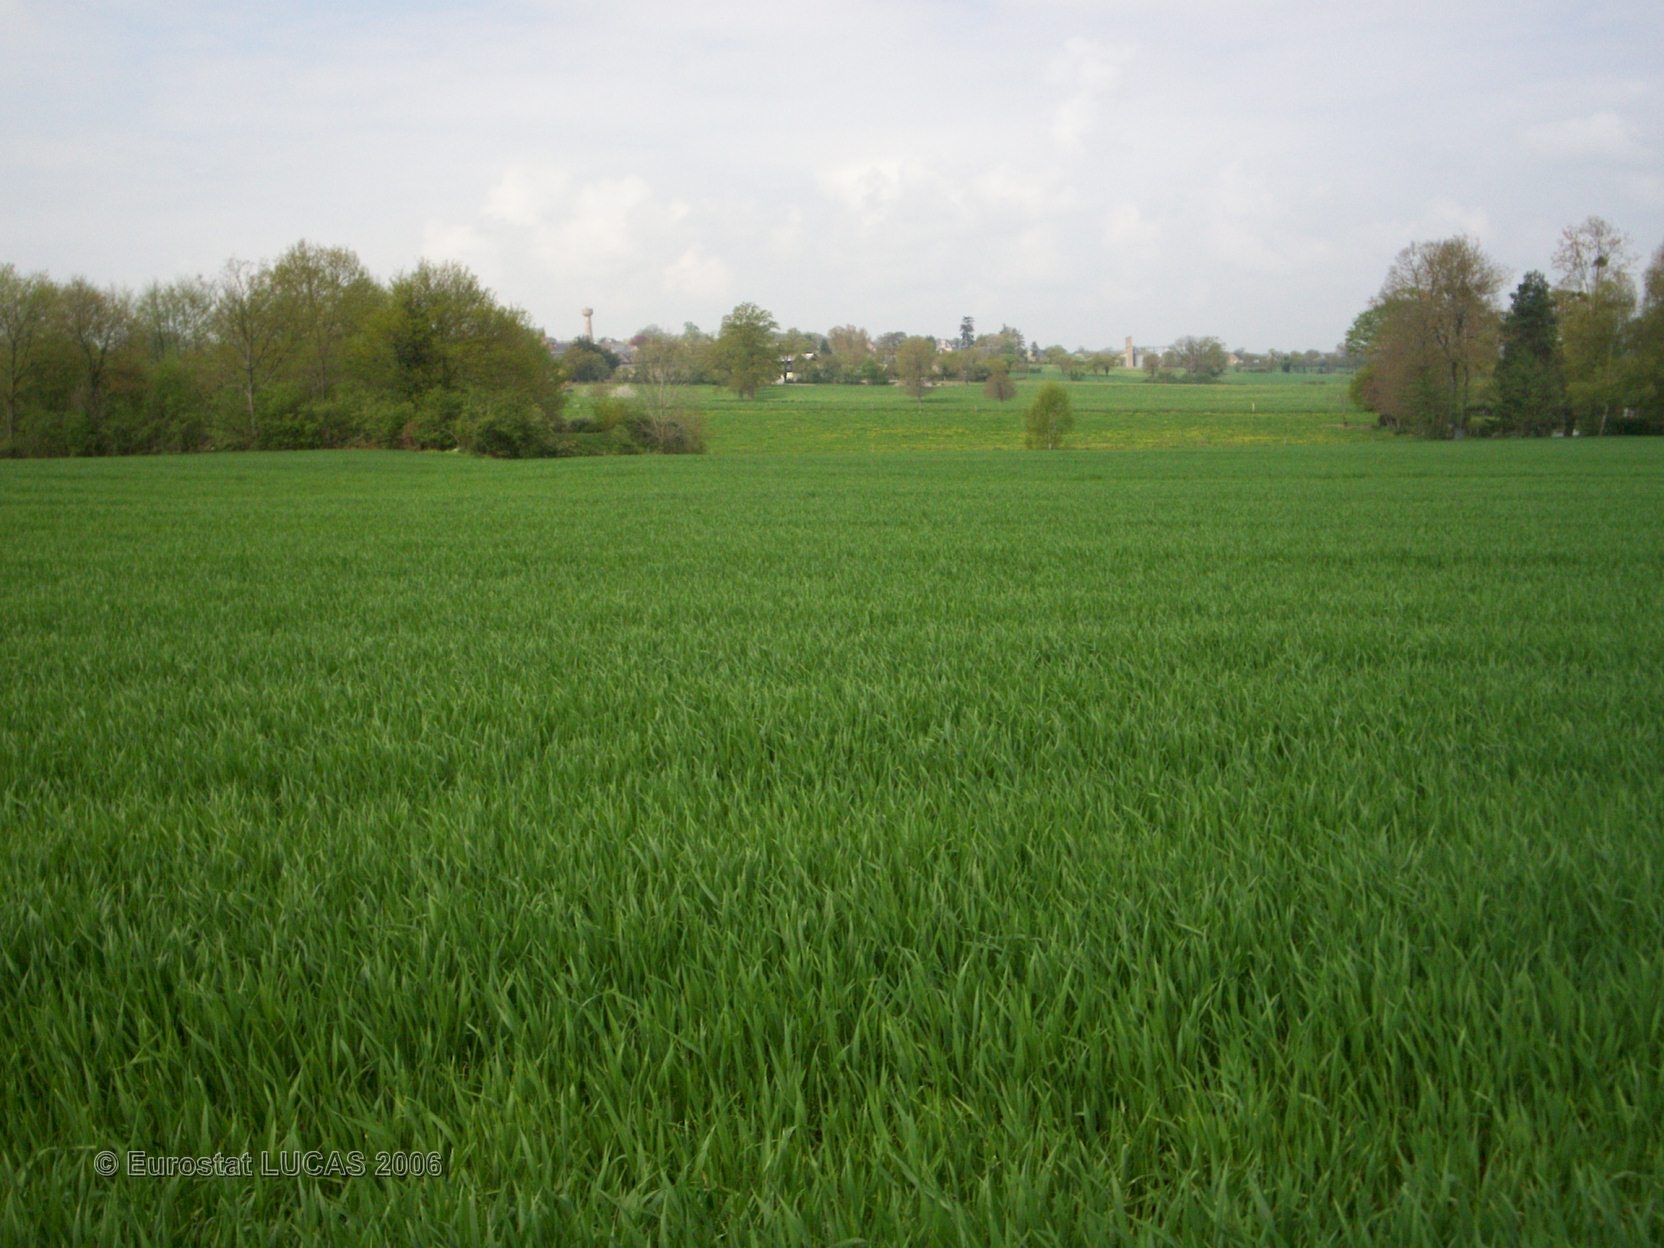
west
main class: Cropland
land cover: Common wheat
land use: Agriculture (excluding fallow land and kitchen gardens)
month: April
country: FR
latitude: 47.8326
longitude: -1.5476
